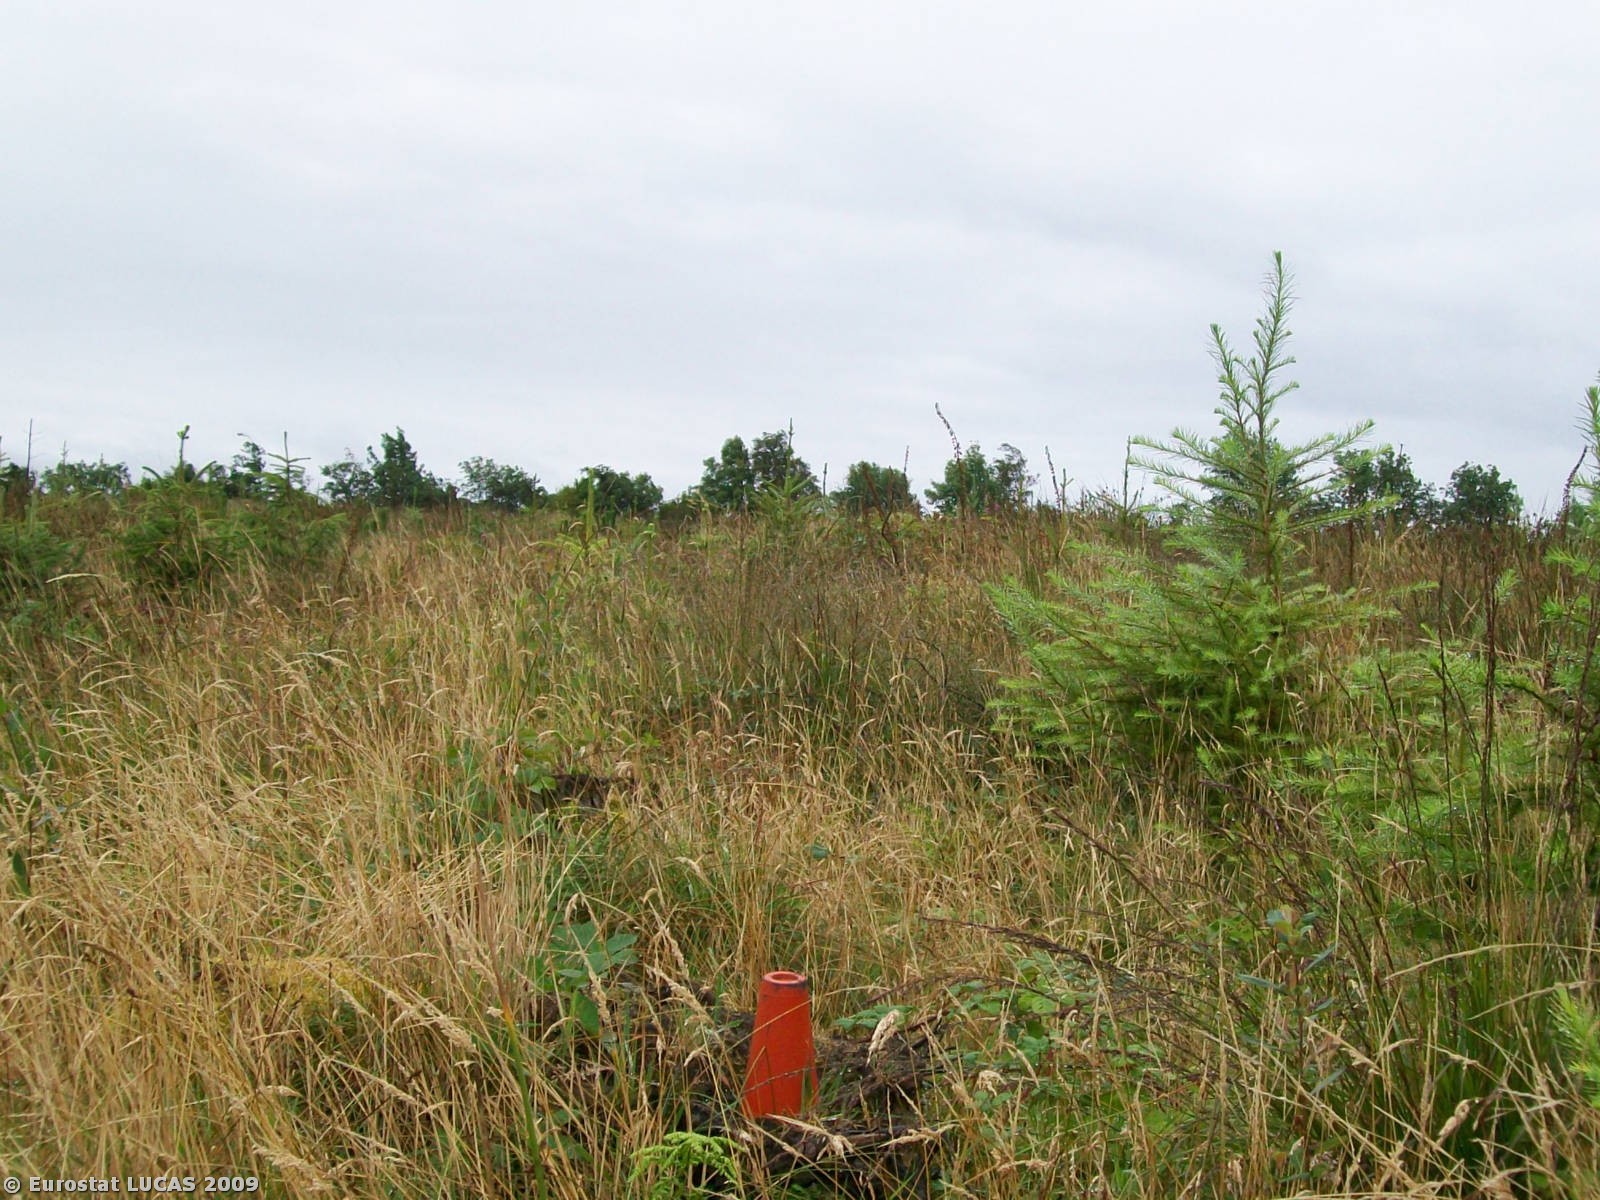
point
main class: Woodland
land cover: Coniferous woodland
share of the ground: > 75 %
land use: Forestry
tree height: < 5 m
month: August
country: IE
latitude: 52.7993
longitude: -9.1286
